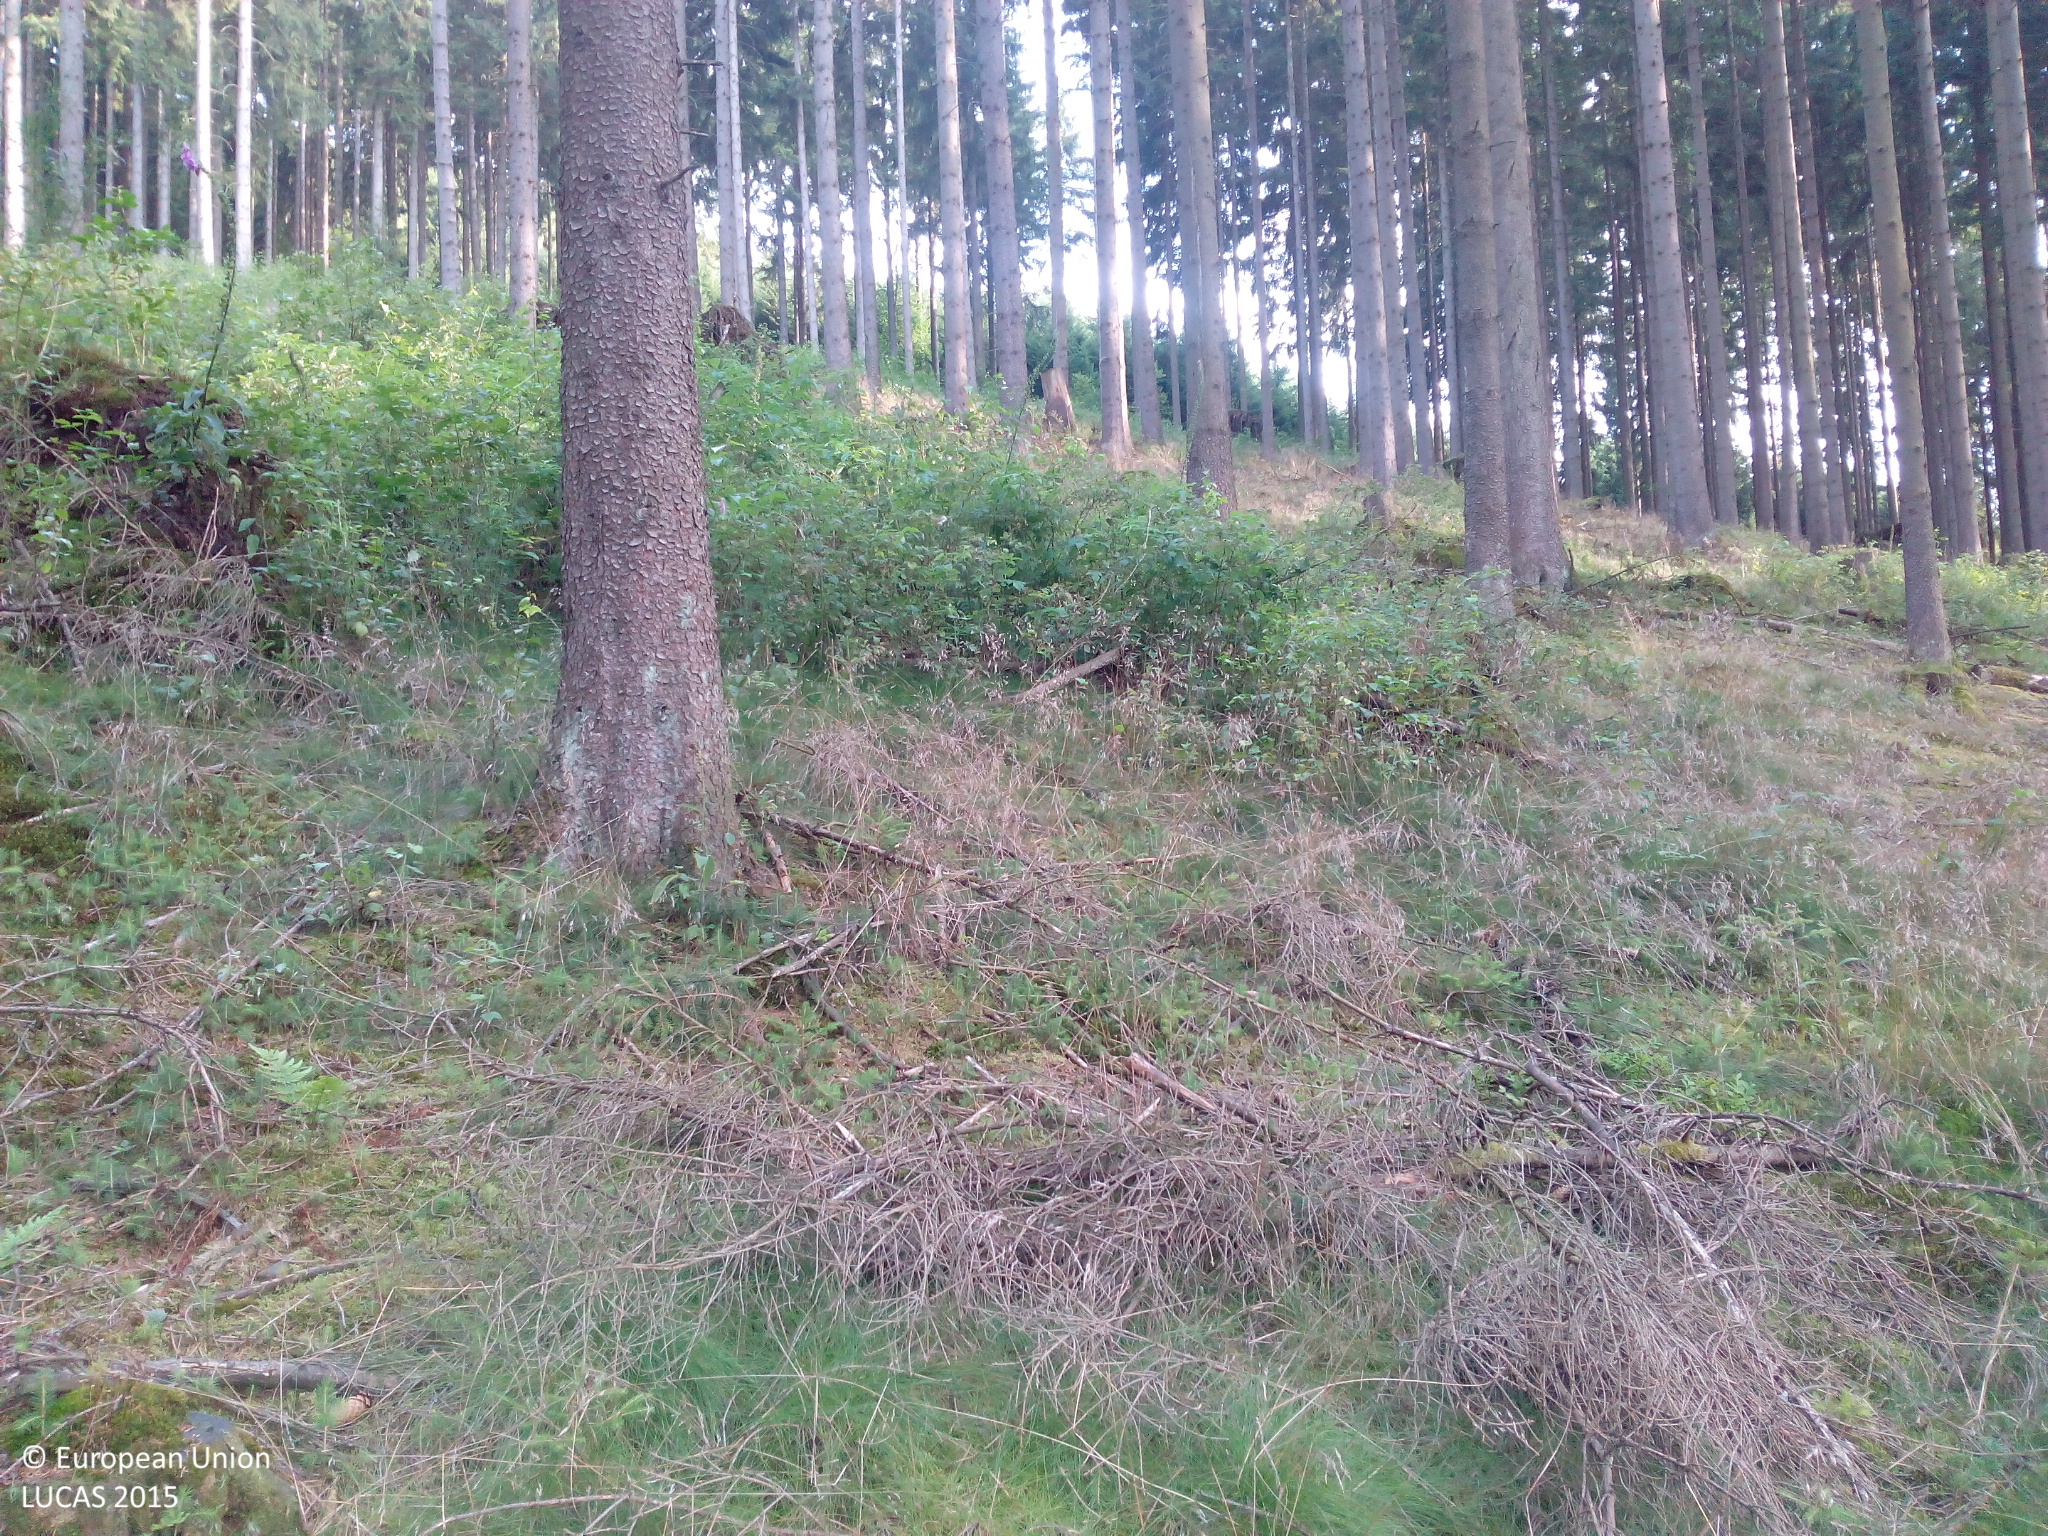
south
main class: Woodland
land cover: Spruce dominated coniferous woodland
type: hemiboreal forest and nemoral coniferous forest and mixed broadleaved-coniferous forest
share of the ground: > 75 %
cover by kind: coniferous forest trees 80 %, herbaceous plants 10 %, lichens and mosses 10 %
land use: Forestry
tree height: > 5 m
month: August
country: DE
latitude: 51.0838
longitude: 7.9875
